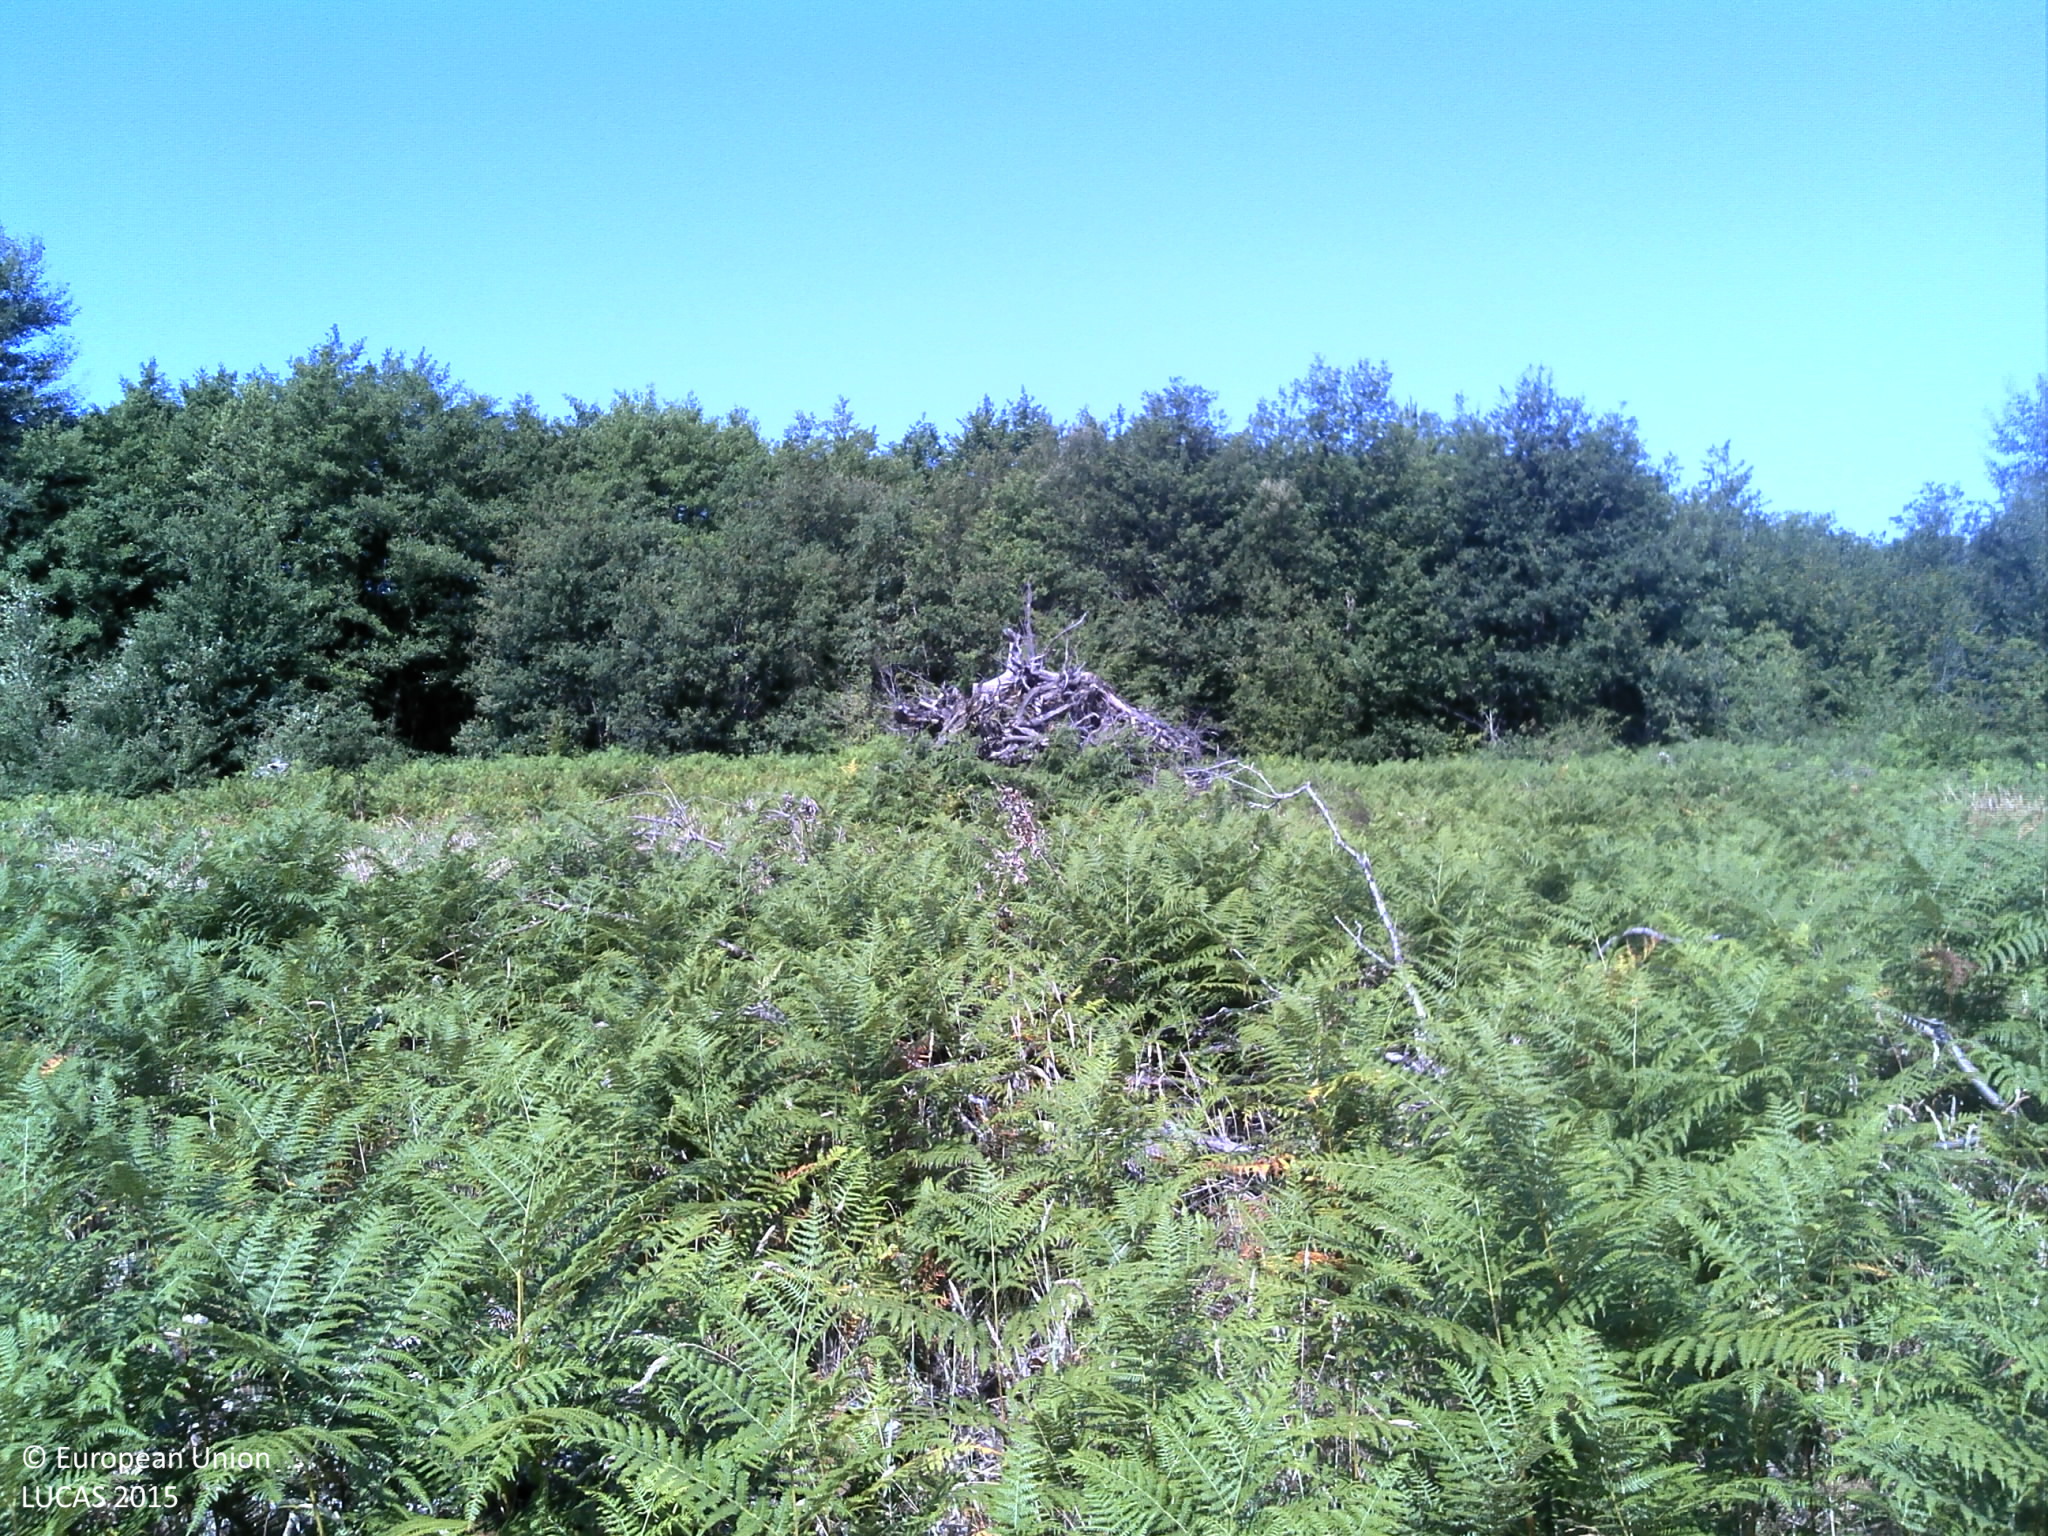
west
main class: Grassland
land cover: Spontaneously vegetated surfaces
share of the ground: > 75 %
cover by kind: herbaceous plants 90 %, shrubs 5 %, lichens and mosses 5 %
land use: Semi-natural and natural areas not in use
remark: Clear cut
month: July
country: FR
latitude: 44.3878
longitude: -0.4208
